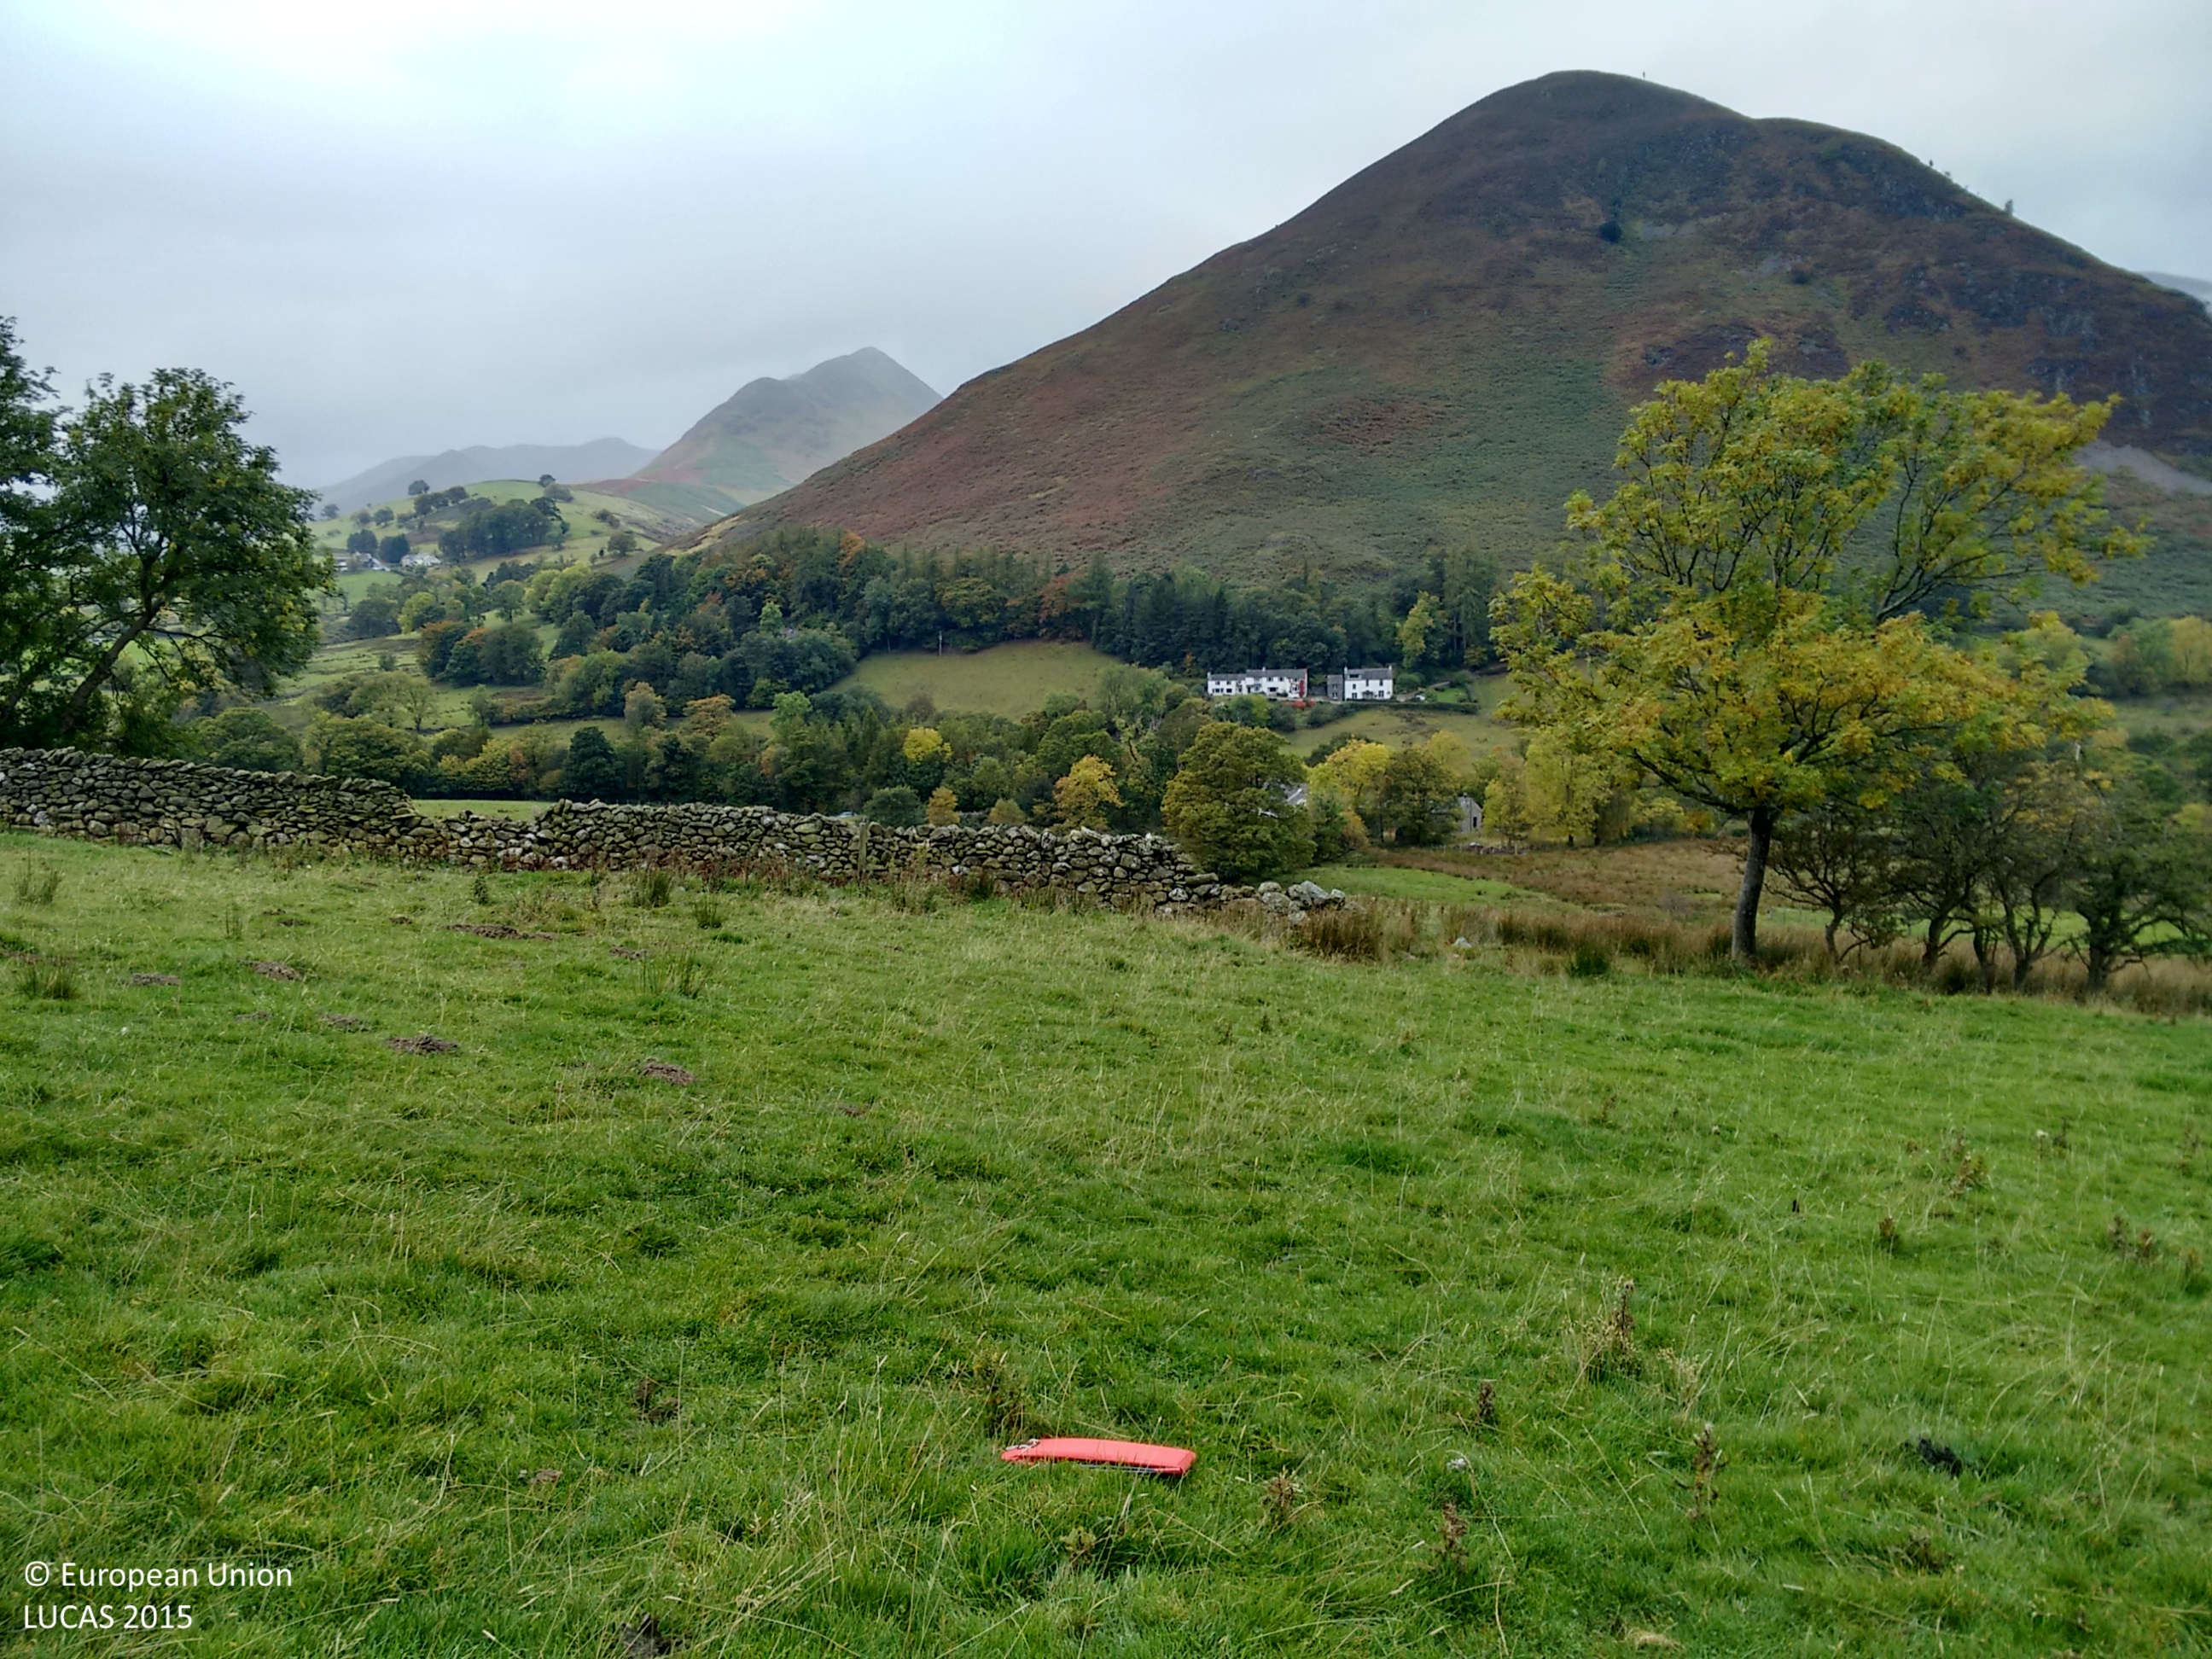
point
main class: Grassland
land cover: Grassland without tree/shrub cover
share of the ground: > 75 %
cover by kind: herbaceous plants 100 %
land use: Agriculture (excluding fallow land and kitchen gardens)
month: October
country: GB
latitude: 54.5739
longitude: -3.1781
